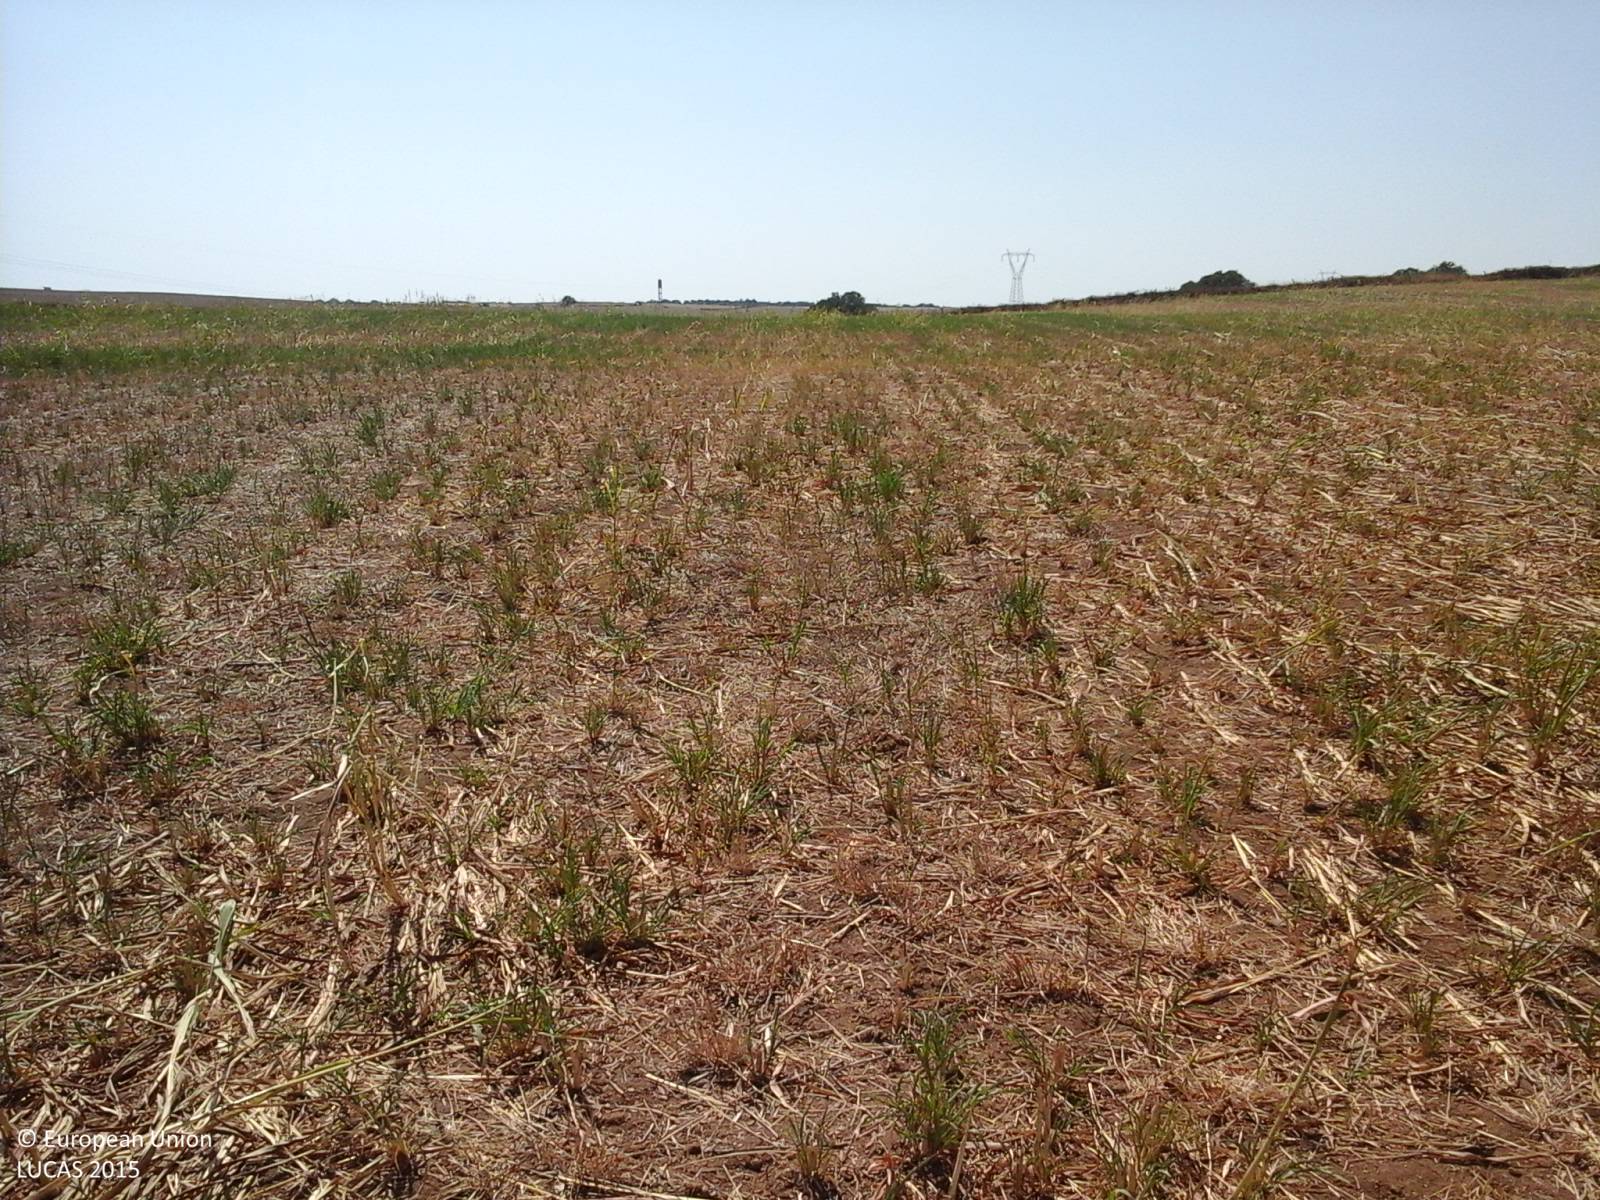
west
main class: Cropland
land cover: Maize
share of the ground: > 75 %
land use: Agriculture (excluding fallow land and kitchen gardens)
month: August
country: IT
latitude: 42.0513
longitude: 12.2271
